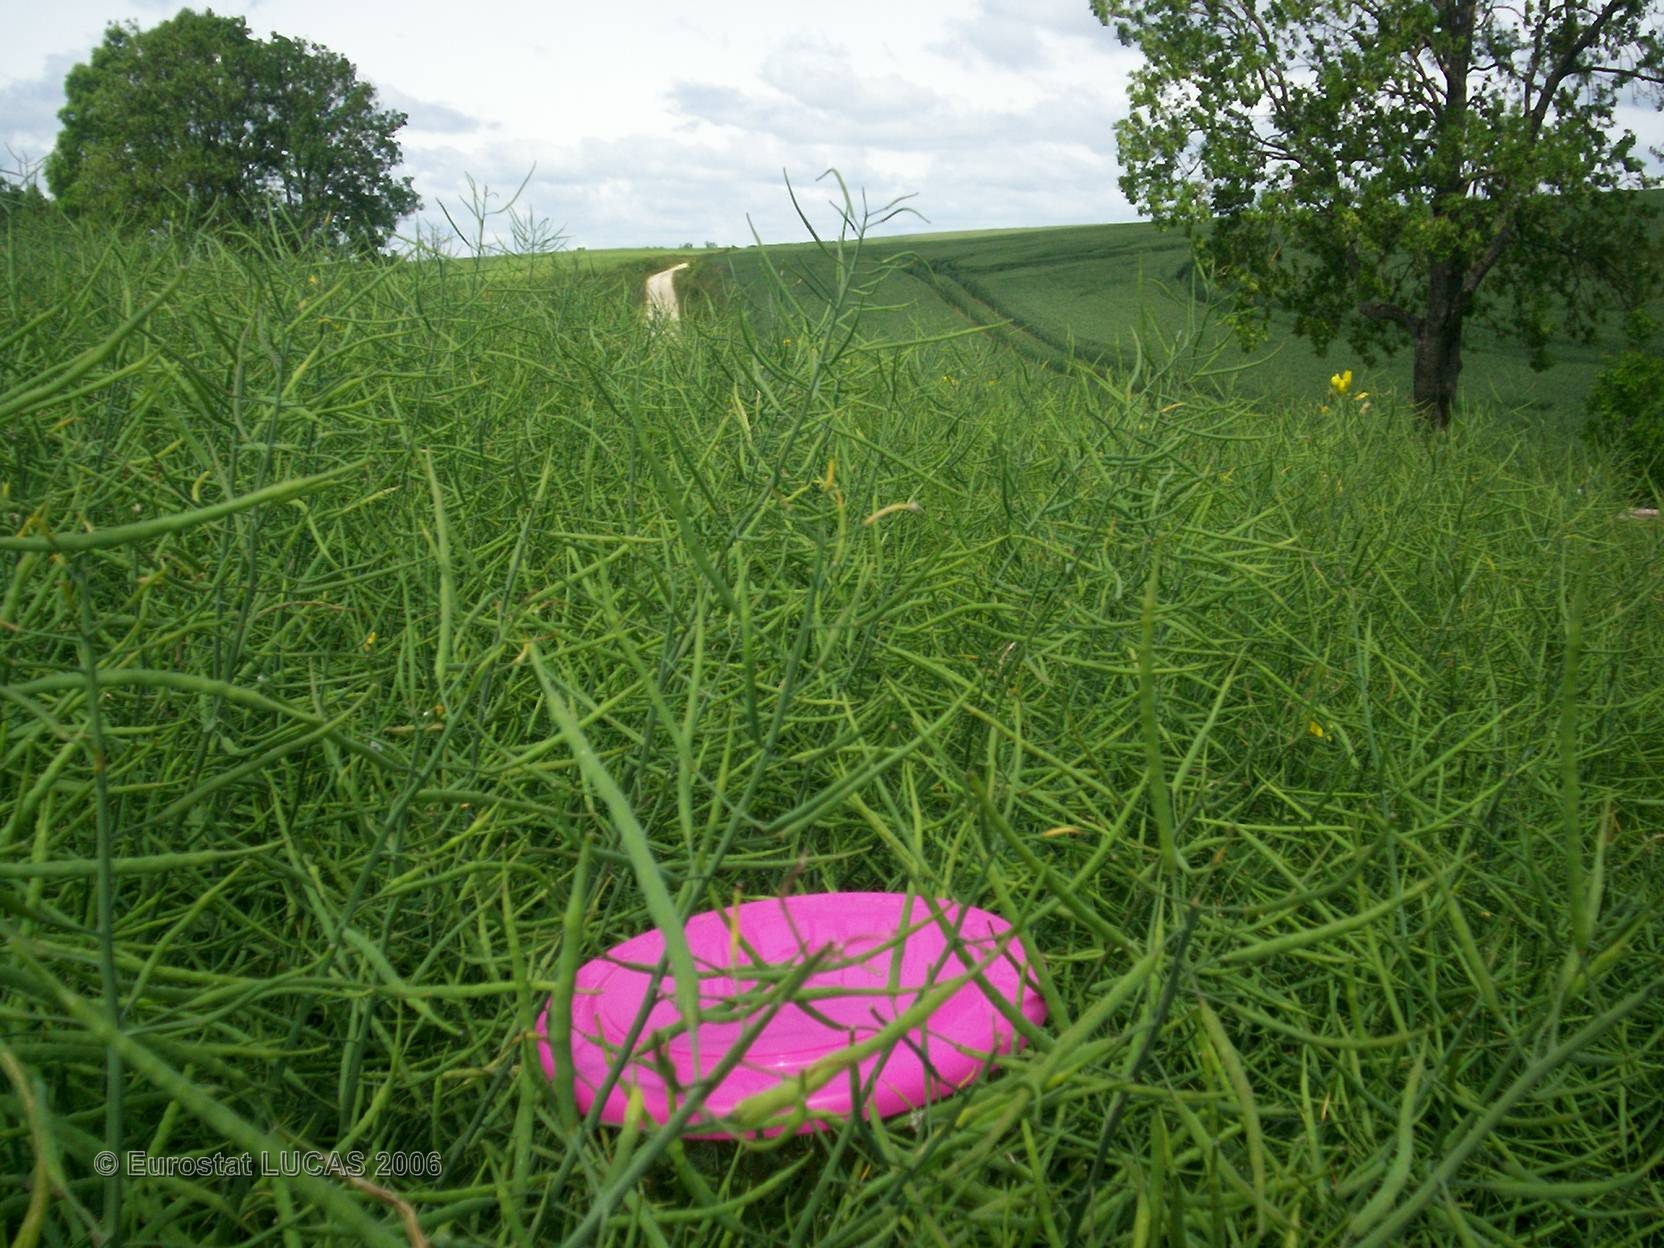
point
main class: Cropland
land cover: Rape and turnip rape
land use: Agriculture (excluding fallow land and kitchen gardens)
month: June
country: FR
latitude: 49.2307
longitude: 5.0679
